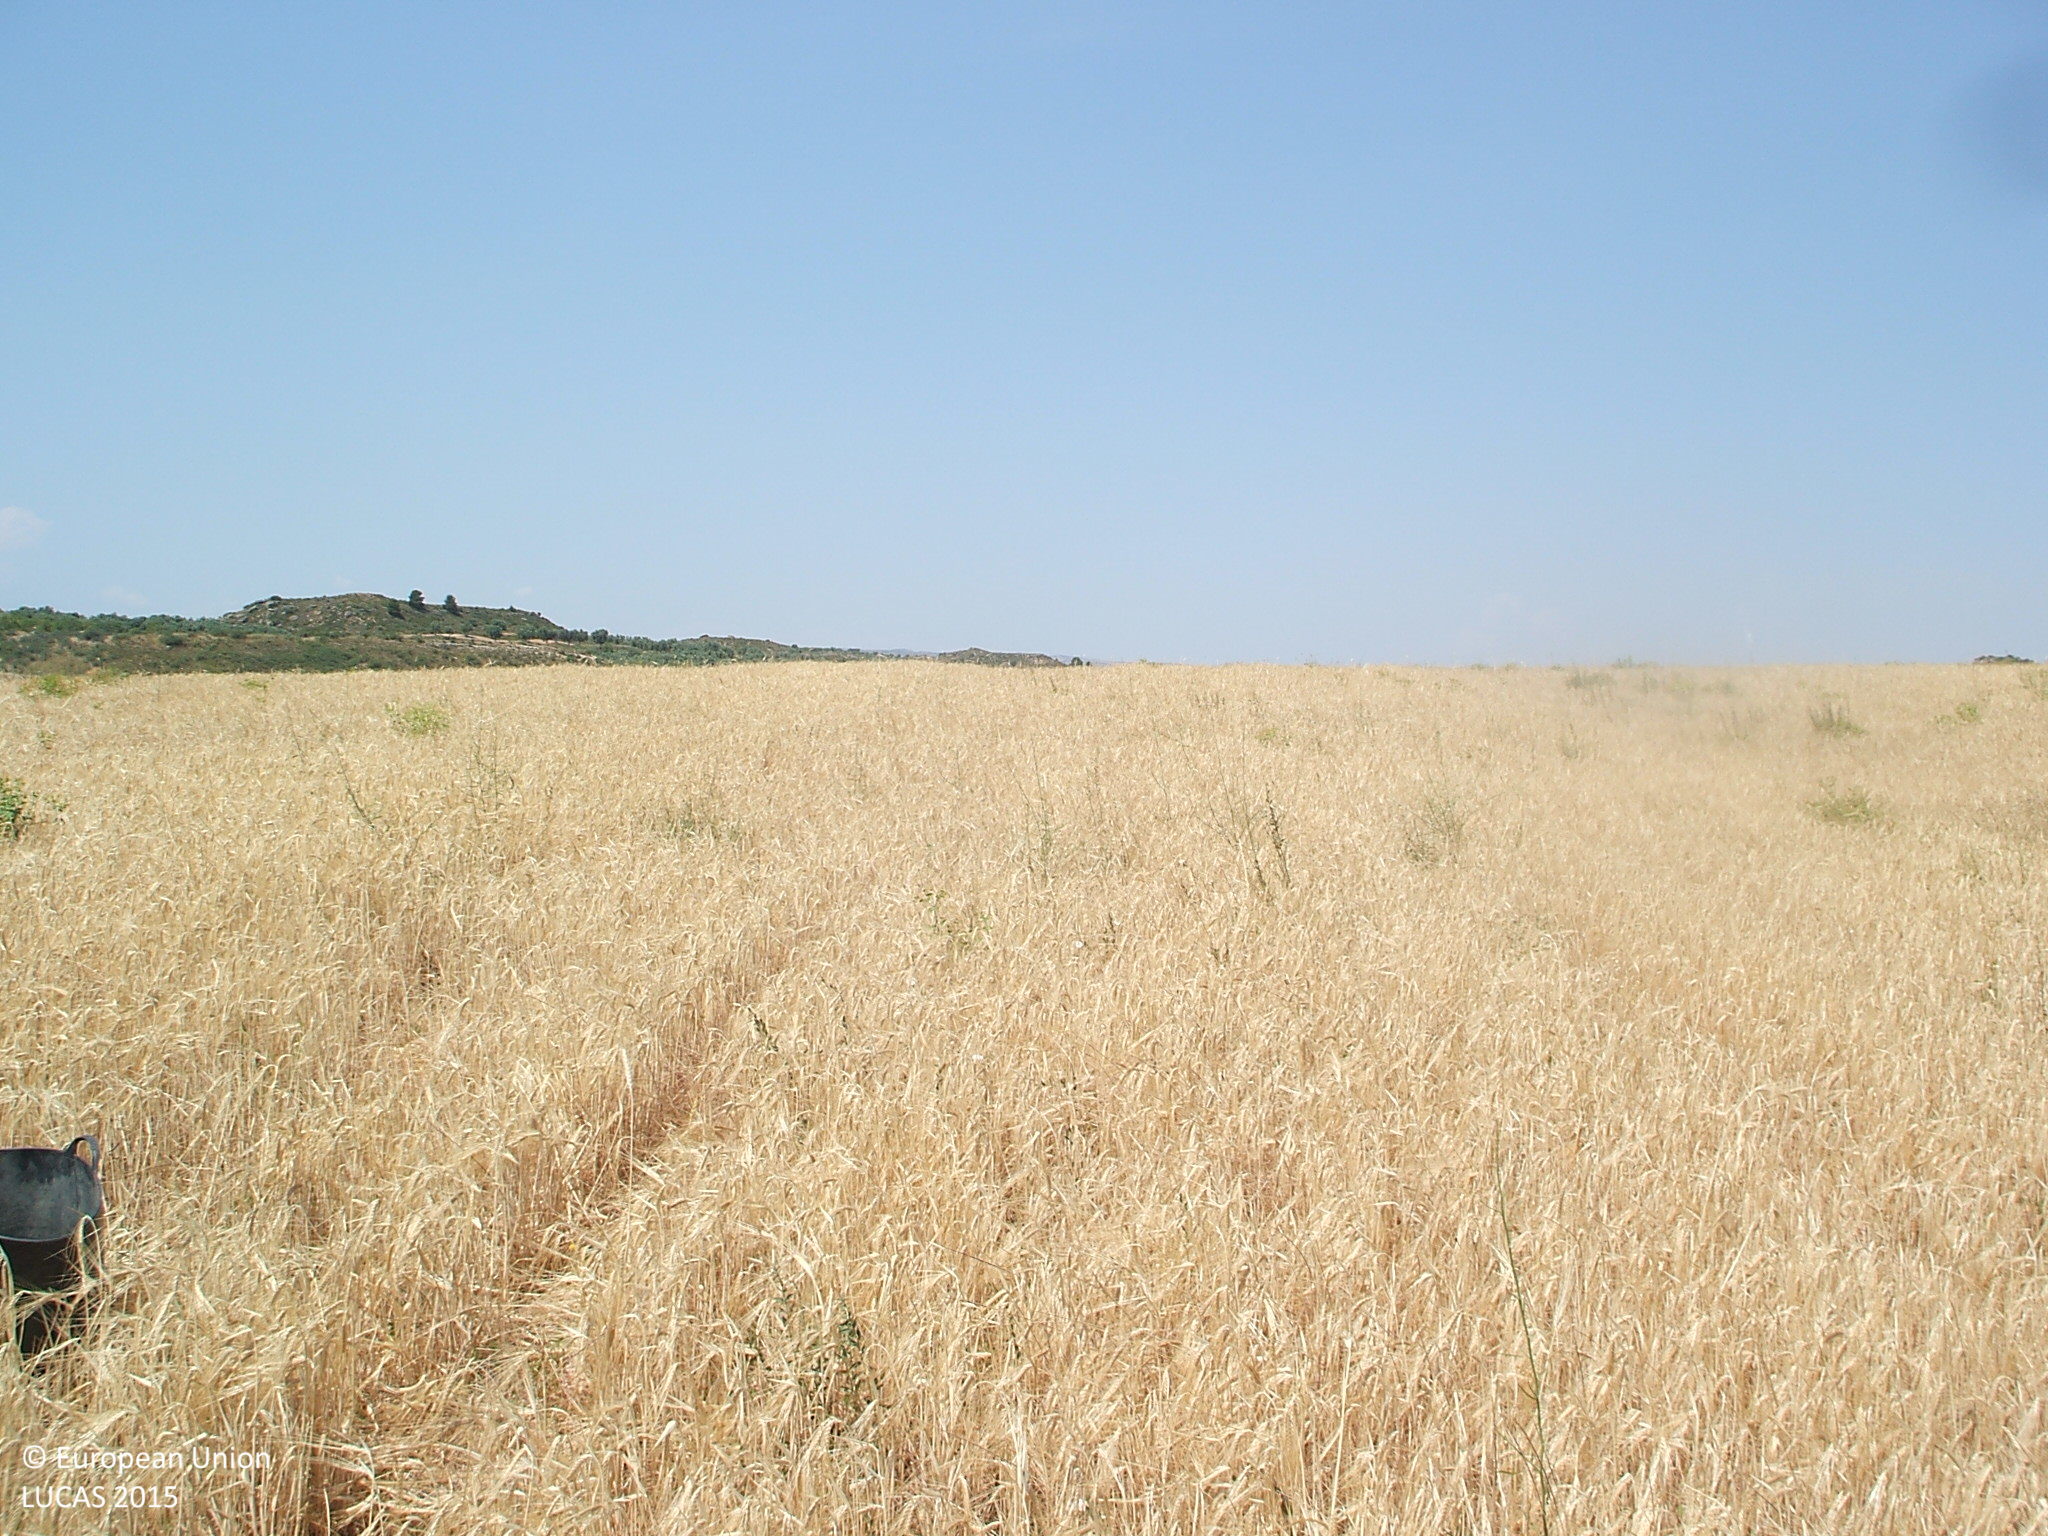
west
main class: Cropland
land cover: Barley
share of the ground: > 75 %
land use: Agriculture (excluding fallow land and kitchen gardens)
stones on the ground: > 50 %
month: June
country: ES
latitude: 40.9760
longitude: -0.1719
